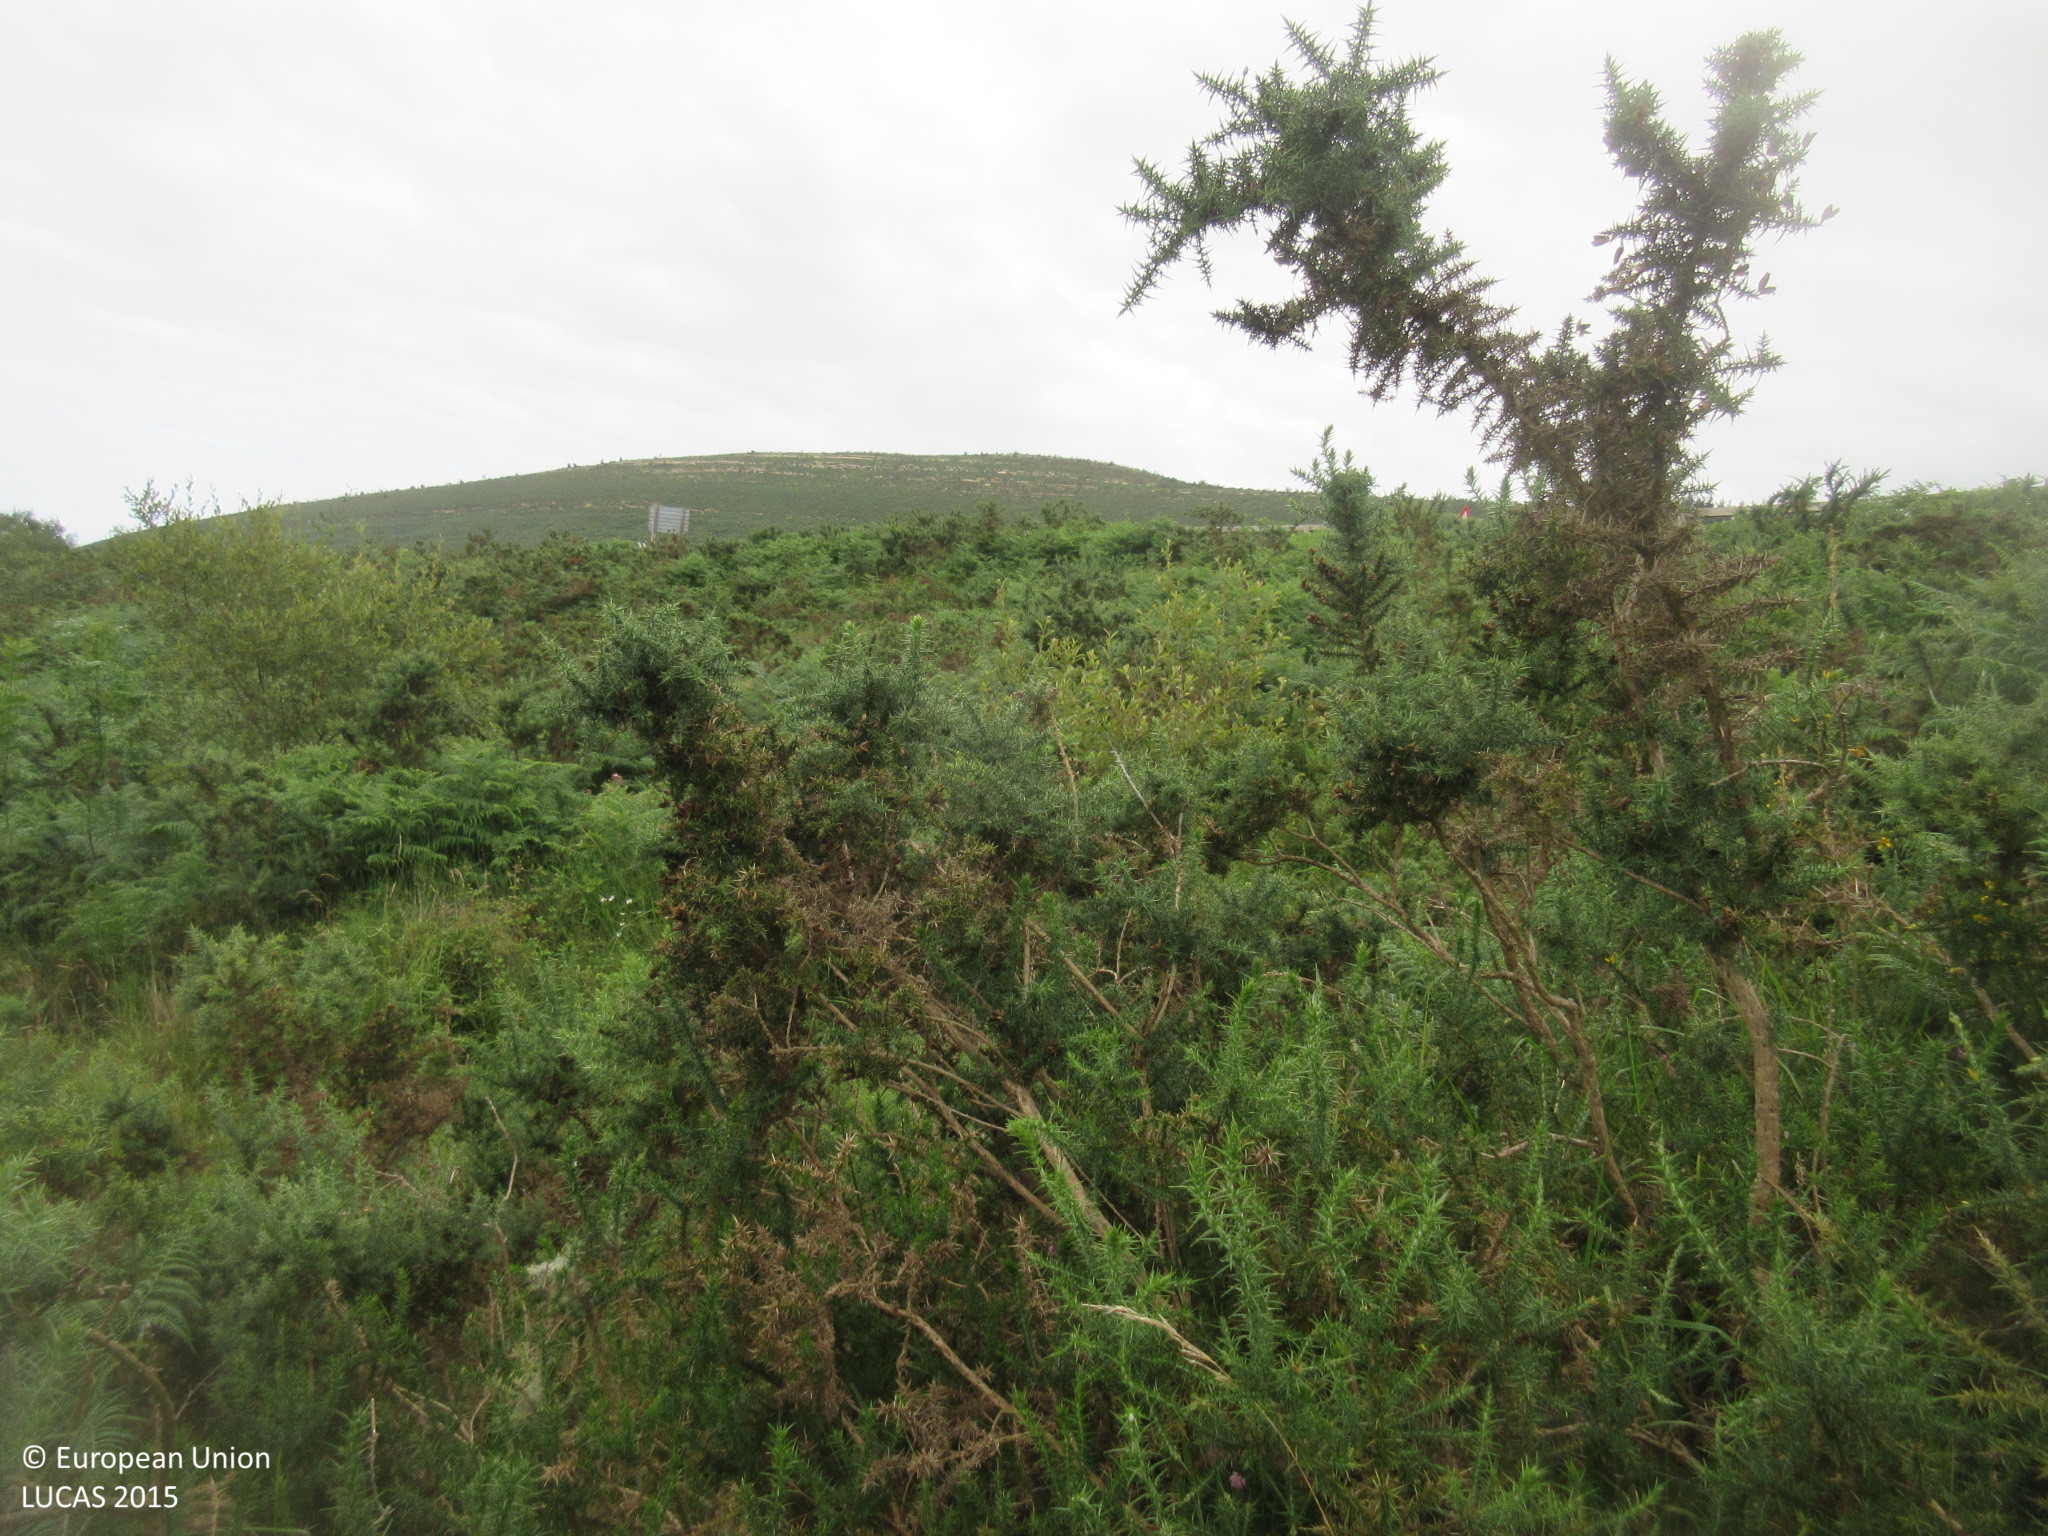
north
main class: Shrubland
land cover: Shrubland without tree cover
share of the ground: 50 - 75 %
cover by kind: shrubs 70 %, herbaceous plants 30 %
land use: Agriculture (excluding fallow land and kitchen gardens)
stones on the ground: < 10 %
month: July
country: ES
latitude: 43.3007
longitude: -4.4191
